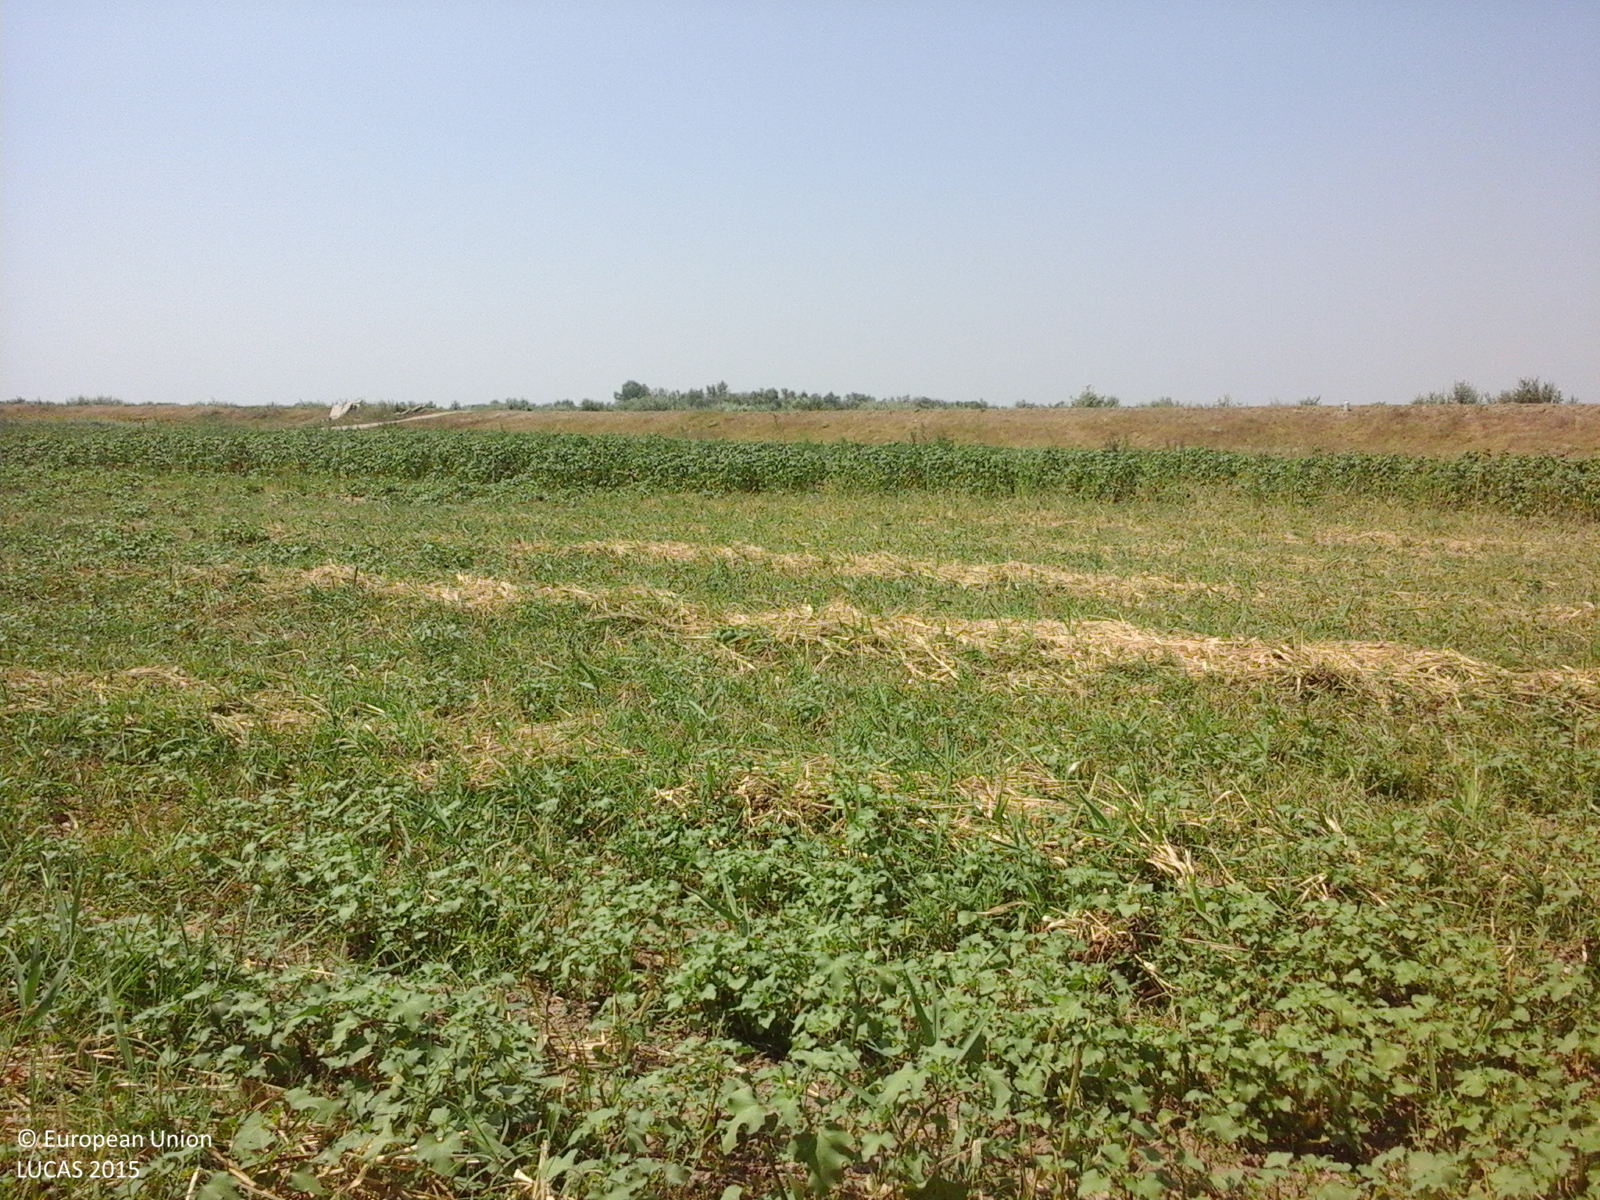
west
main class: Grassland
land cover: Spontaneously vegetated surfaces
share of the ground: > 75 %
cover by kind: herbaceous plants 100 %
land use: Agriculture (excluding fallow land and kitchen gardens)
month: August
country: RO
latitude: 45.1482
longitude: 27.3017
